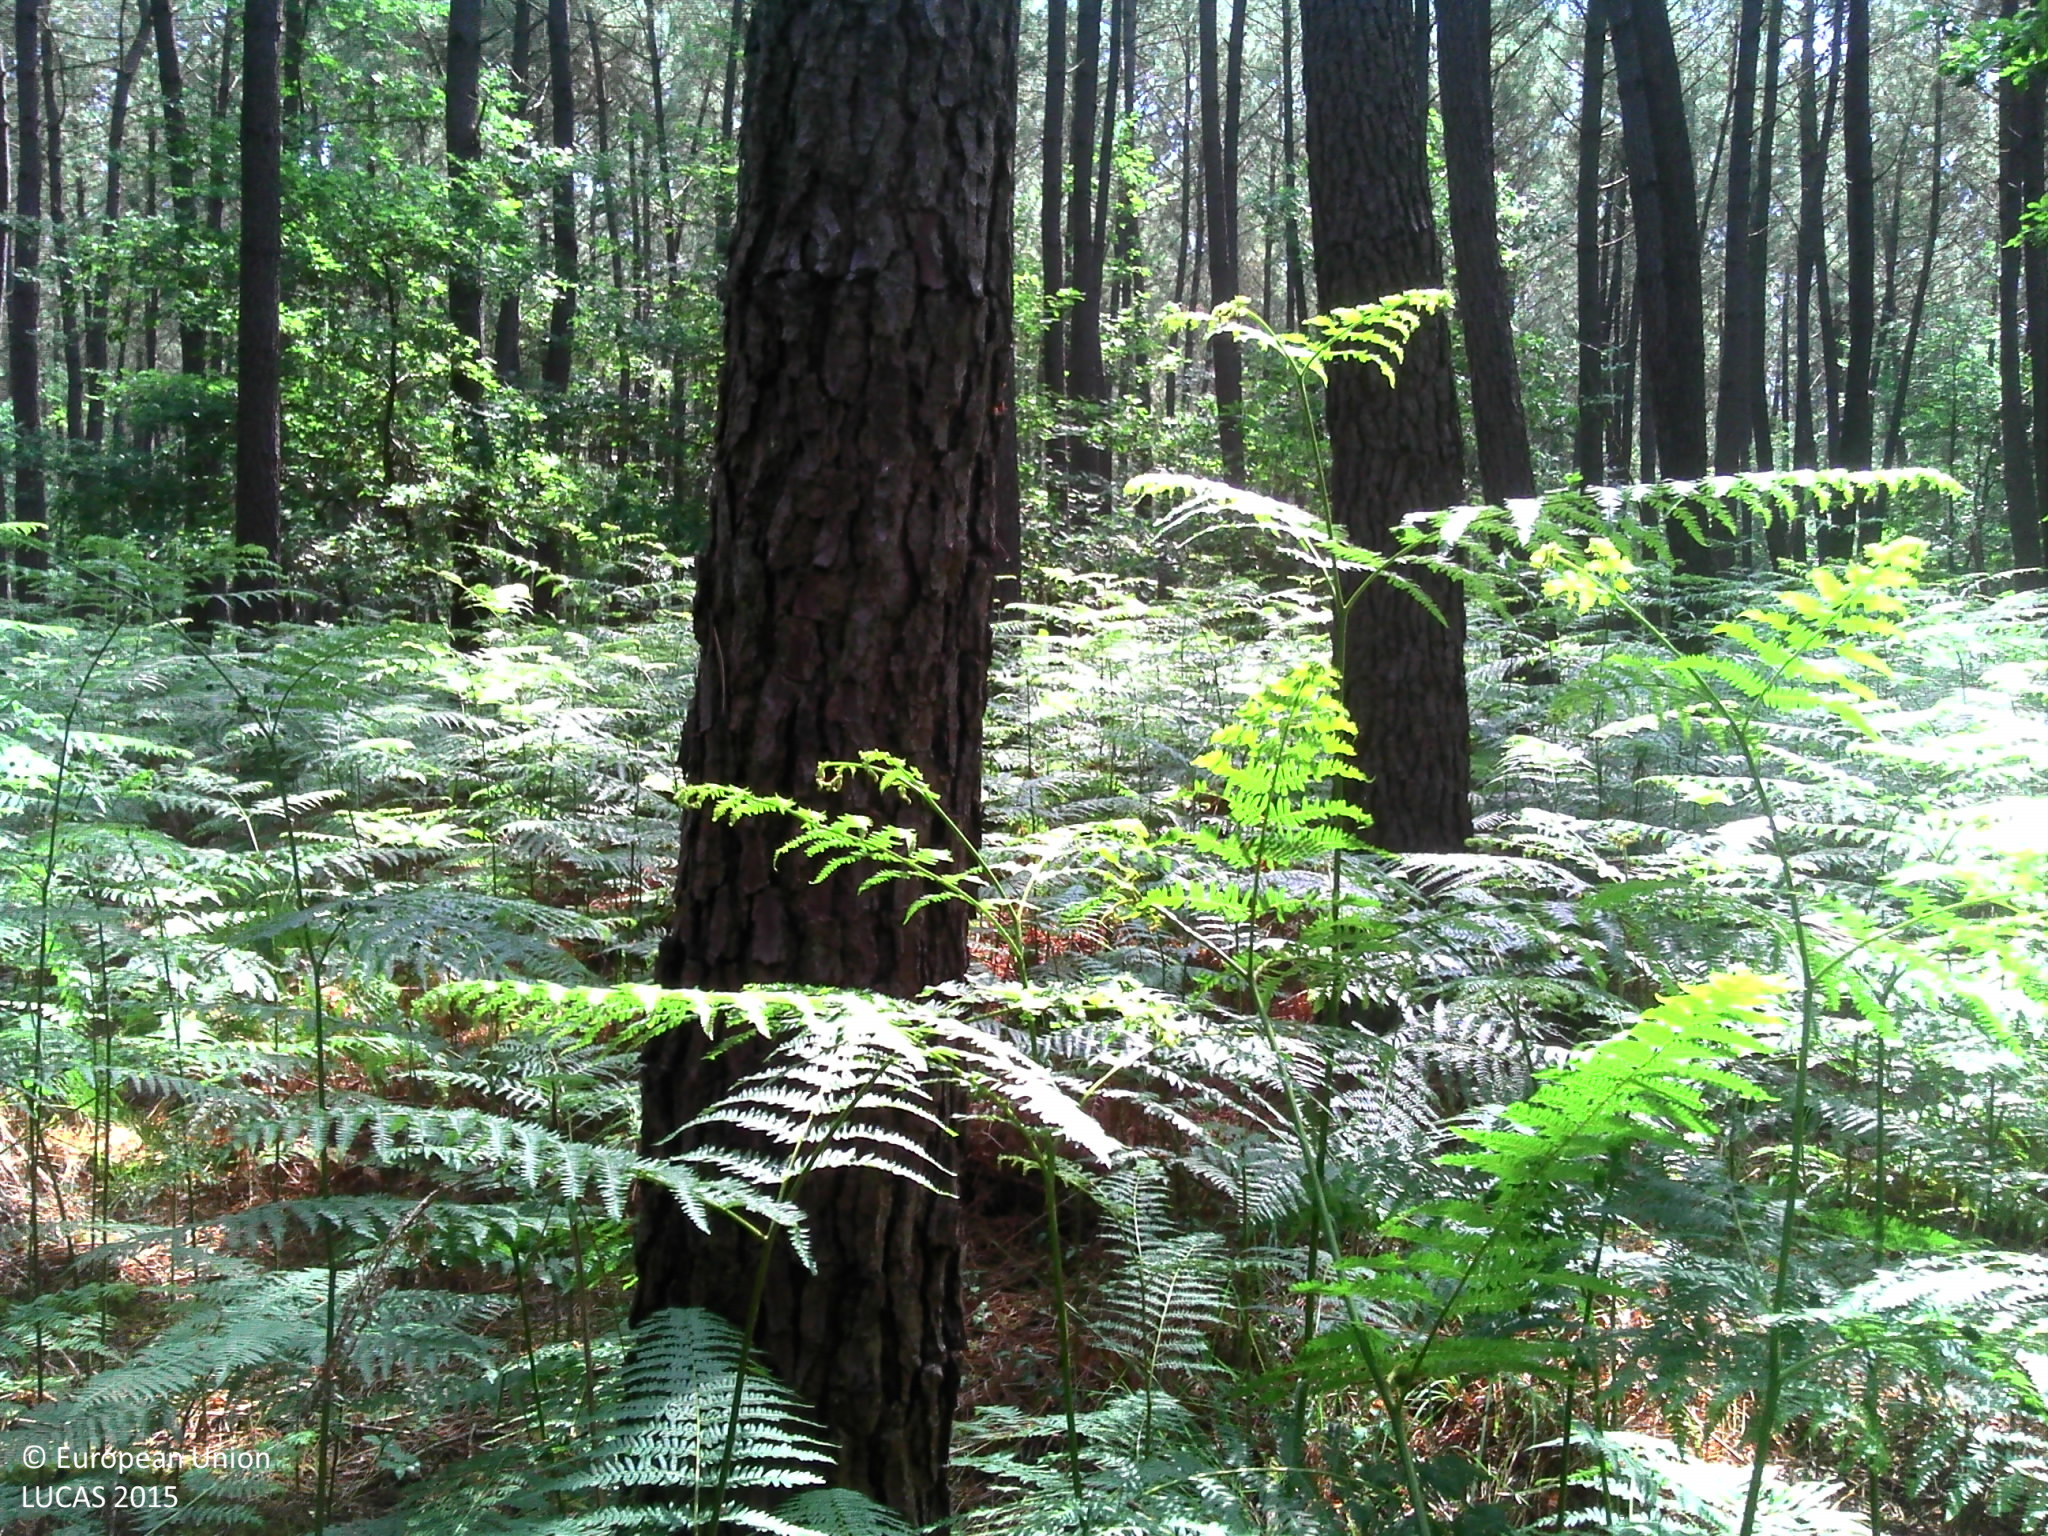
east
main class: Woodland
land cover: Pine dominated coniferous woodland
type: exotic forest
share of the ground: > 75 %
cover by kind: coniferous forest trees 70 %, broadleaved forest trees 15 %, herbaceous plants 15 %
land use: Forestry
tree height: > 5 m
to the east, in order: Pine dominated coniferous woodland; Grass margins; Tracks; Grass margins; Pine dominated coniferous woodland
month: June
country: FR
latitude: 47.1354
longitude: 1.0585
